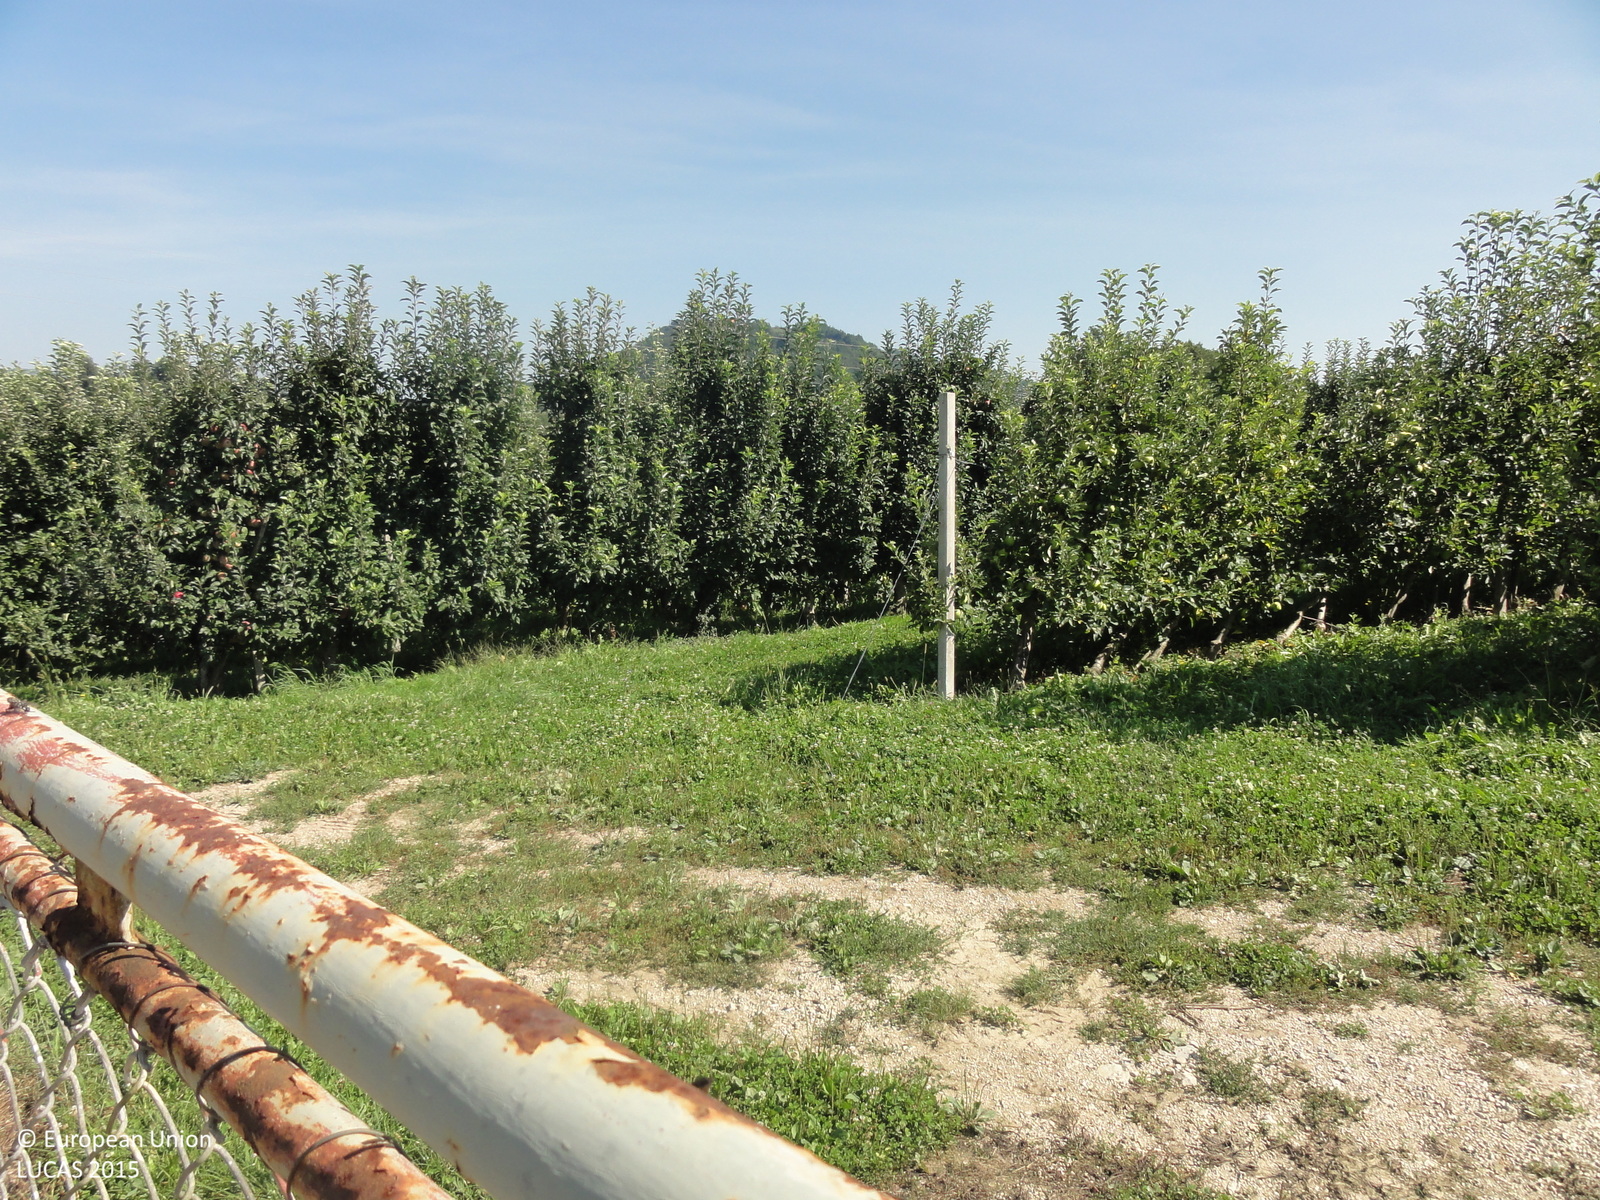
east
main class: Cropland
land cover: Apple fruit
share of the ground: 50 - 75 %
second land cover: Grassland without tree/shrub cover
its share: > 75 %
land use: Agriculture (excluding fallow land and kitchen gardens)
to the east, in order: Apple fruit; Grassland without tree/shrub cover; Electric lines; Apple fruit; Grassland without tree/shrub cover; Broadleaved woodland; Shrubland with sparse tree cover; Apple fruit; Grassland without tree/shrub cover
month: August
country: SI
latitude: 45.9952
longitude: 15.4589
